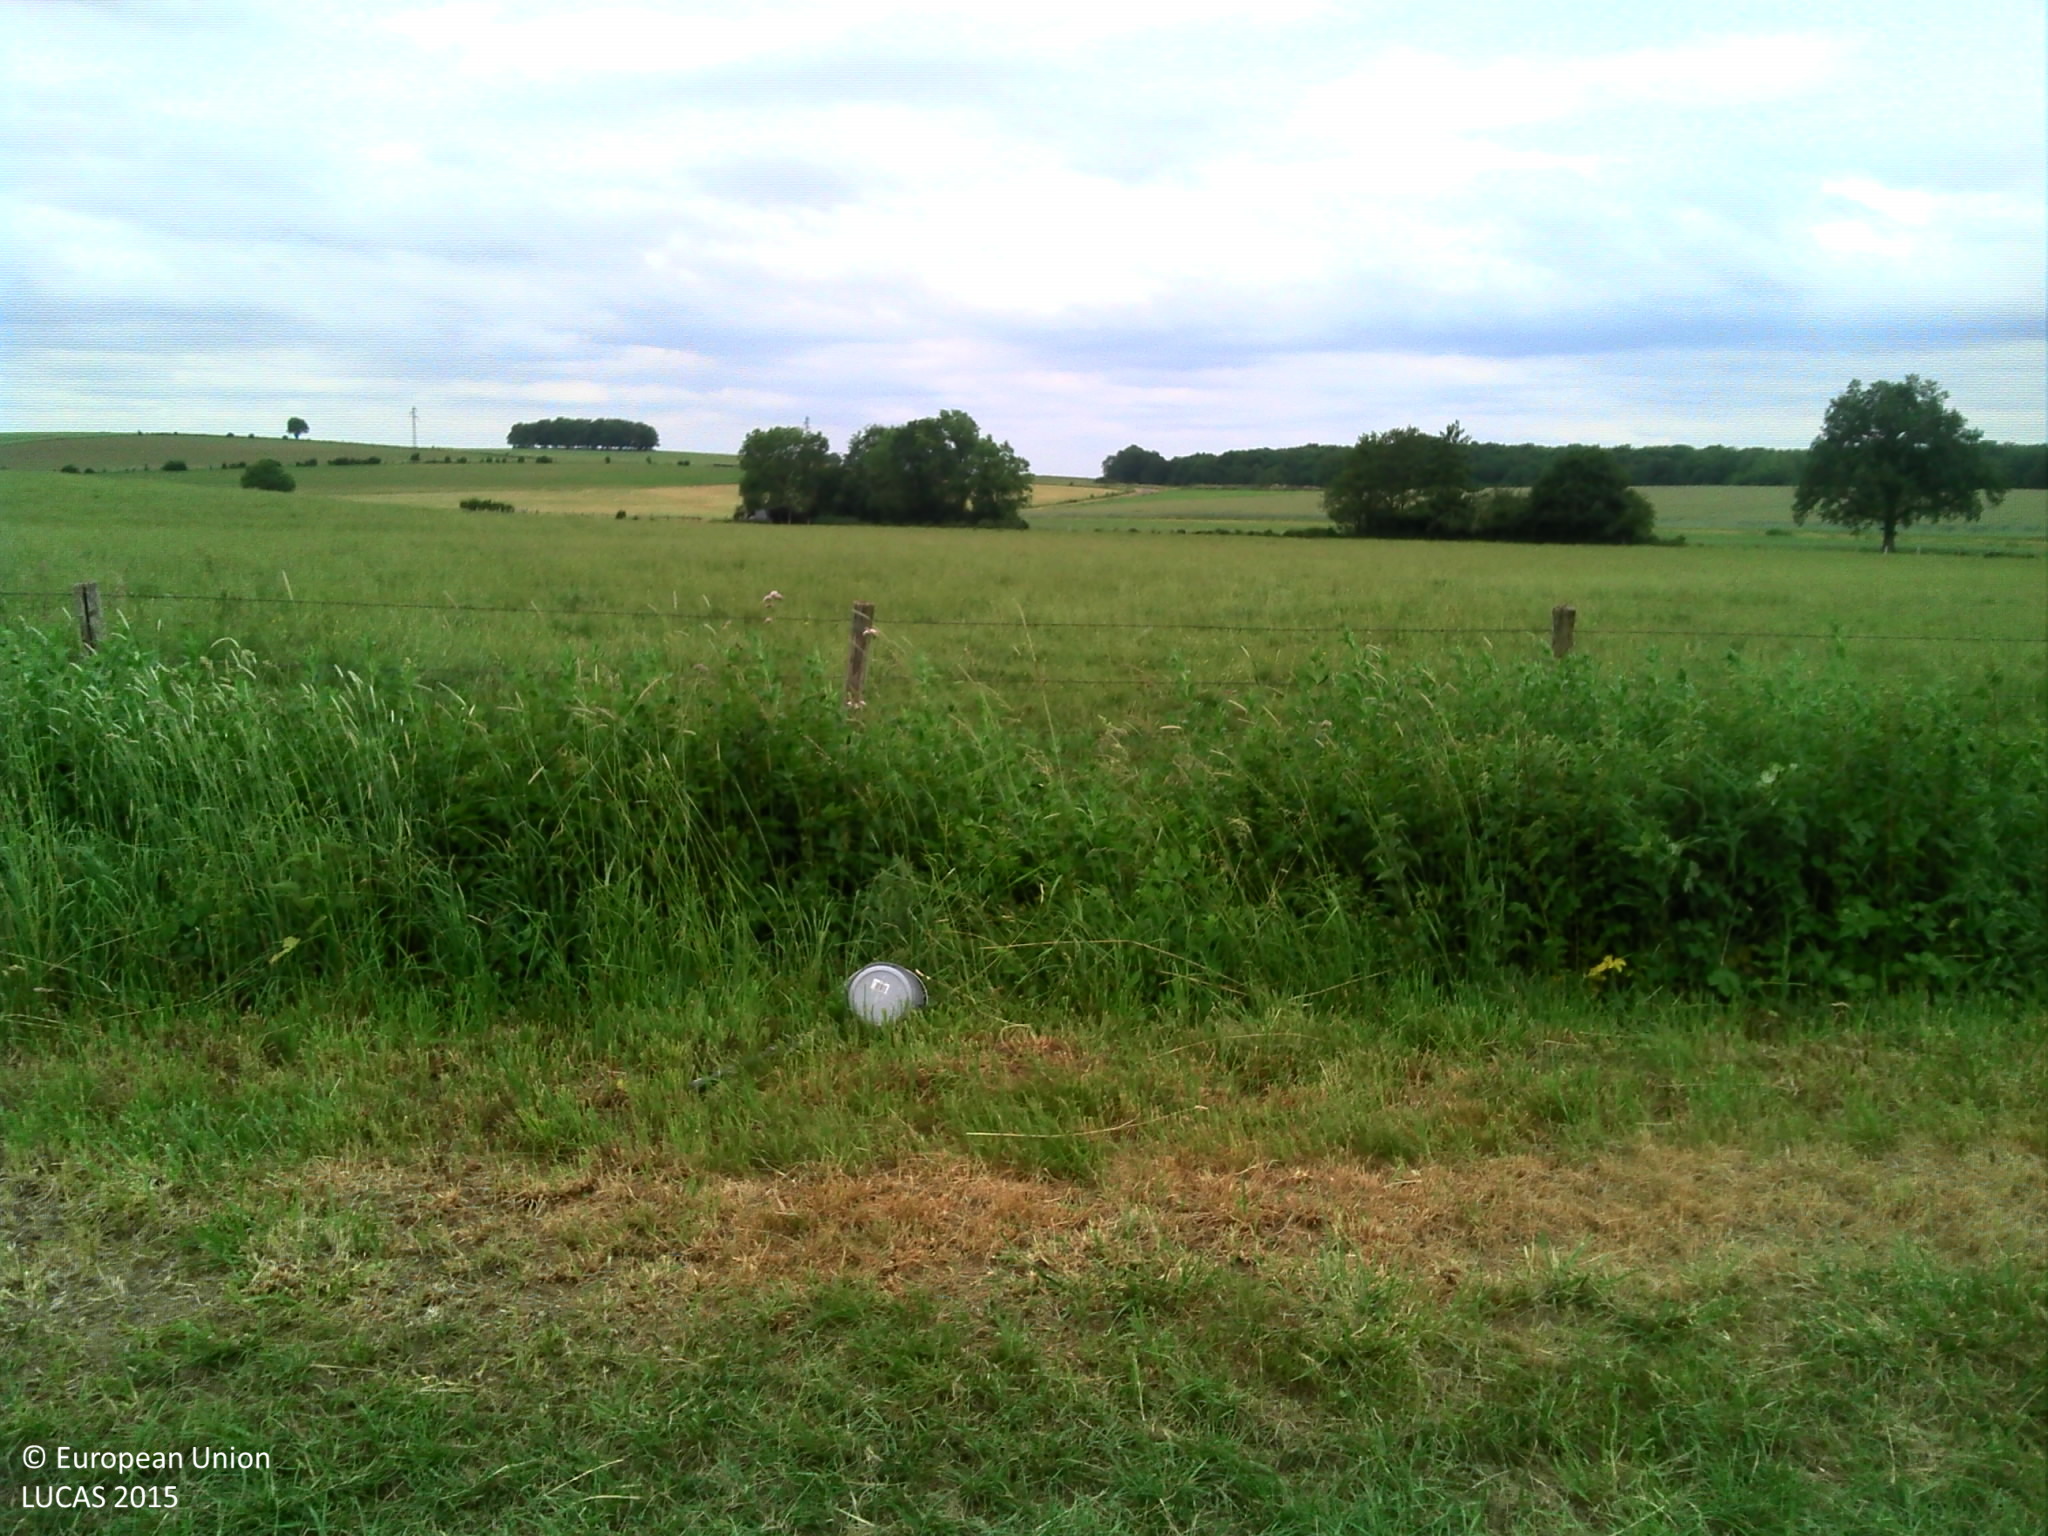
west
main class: Grassland
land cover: Grassland without tree/shrub cover
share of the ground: > 75 %
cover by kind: herbaceous plants 100 %
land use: Agriculture (excluding fallow land and kitchen gardens)
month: June
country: FR
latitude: 47.6233
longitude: 6.3688
